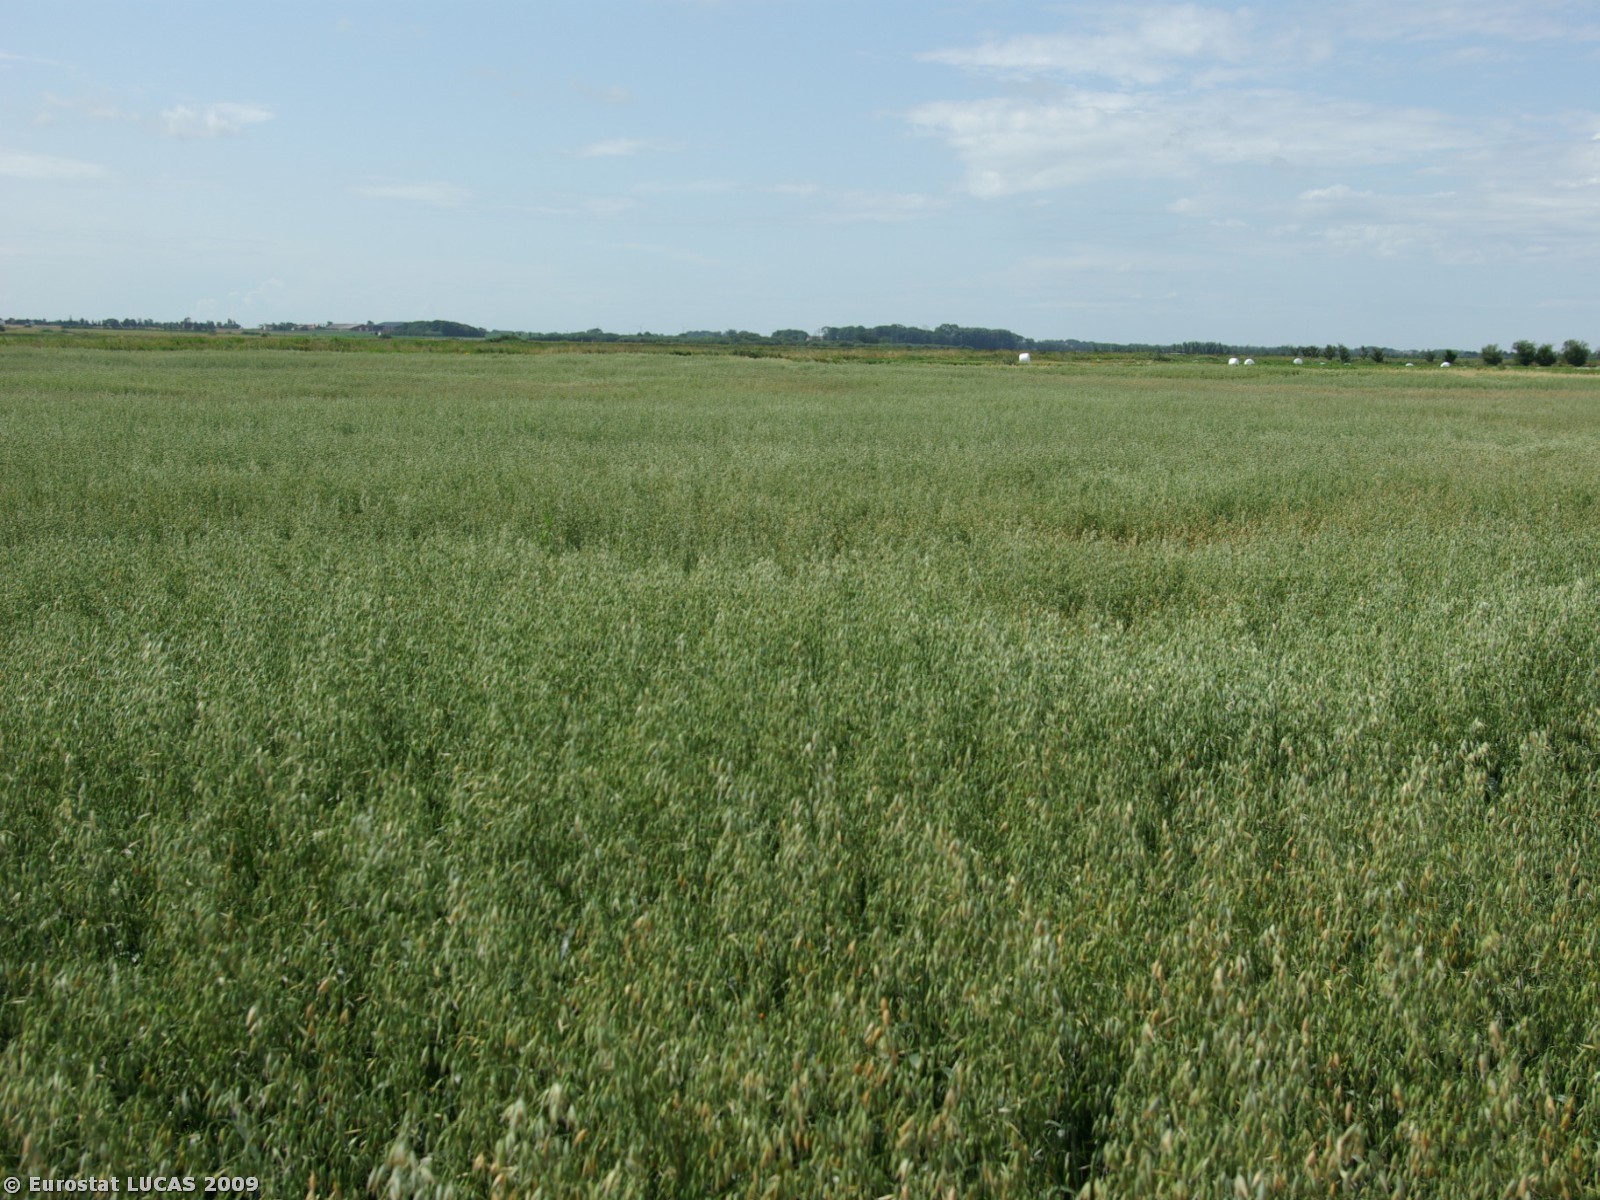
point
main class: Cropland
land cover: Oats
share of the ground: > 75 %
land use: Agriculture (excluding fallow land and kitchen gardens)
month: July
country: DK
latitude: 55.0316
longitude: 8.7962
